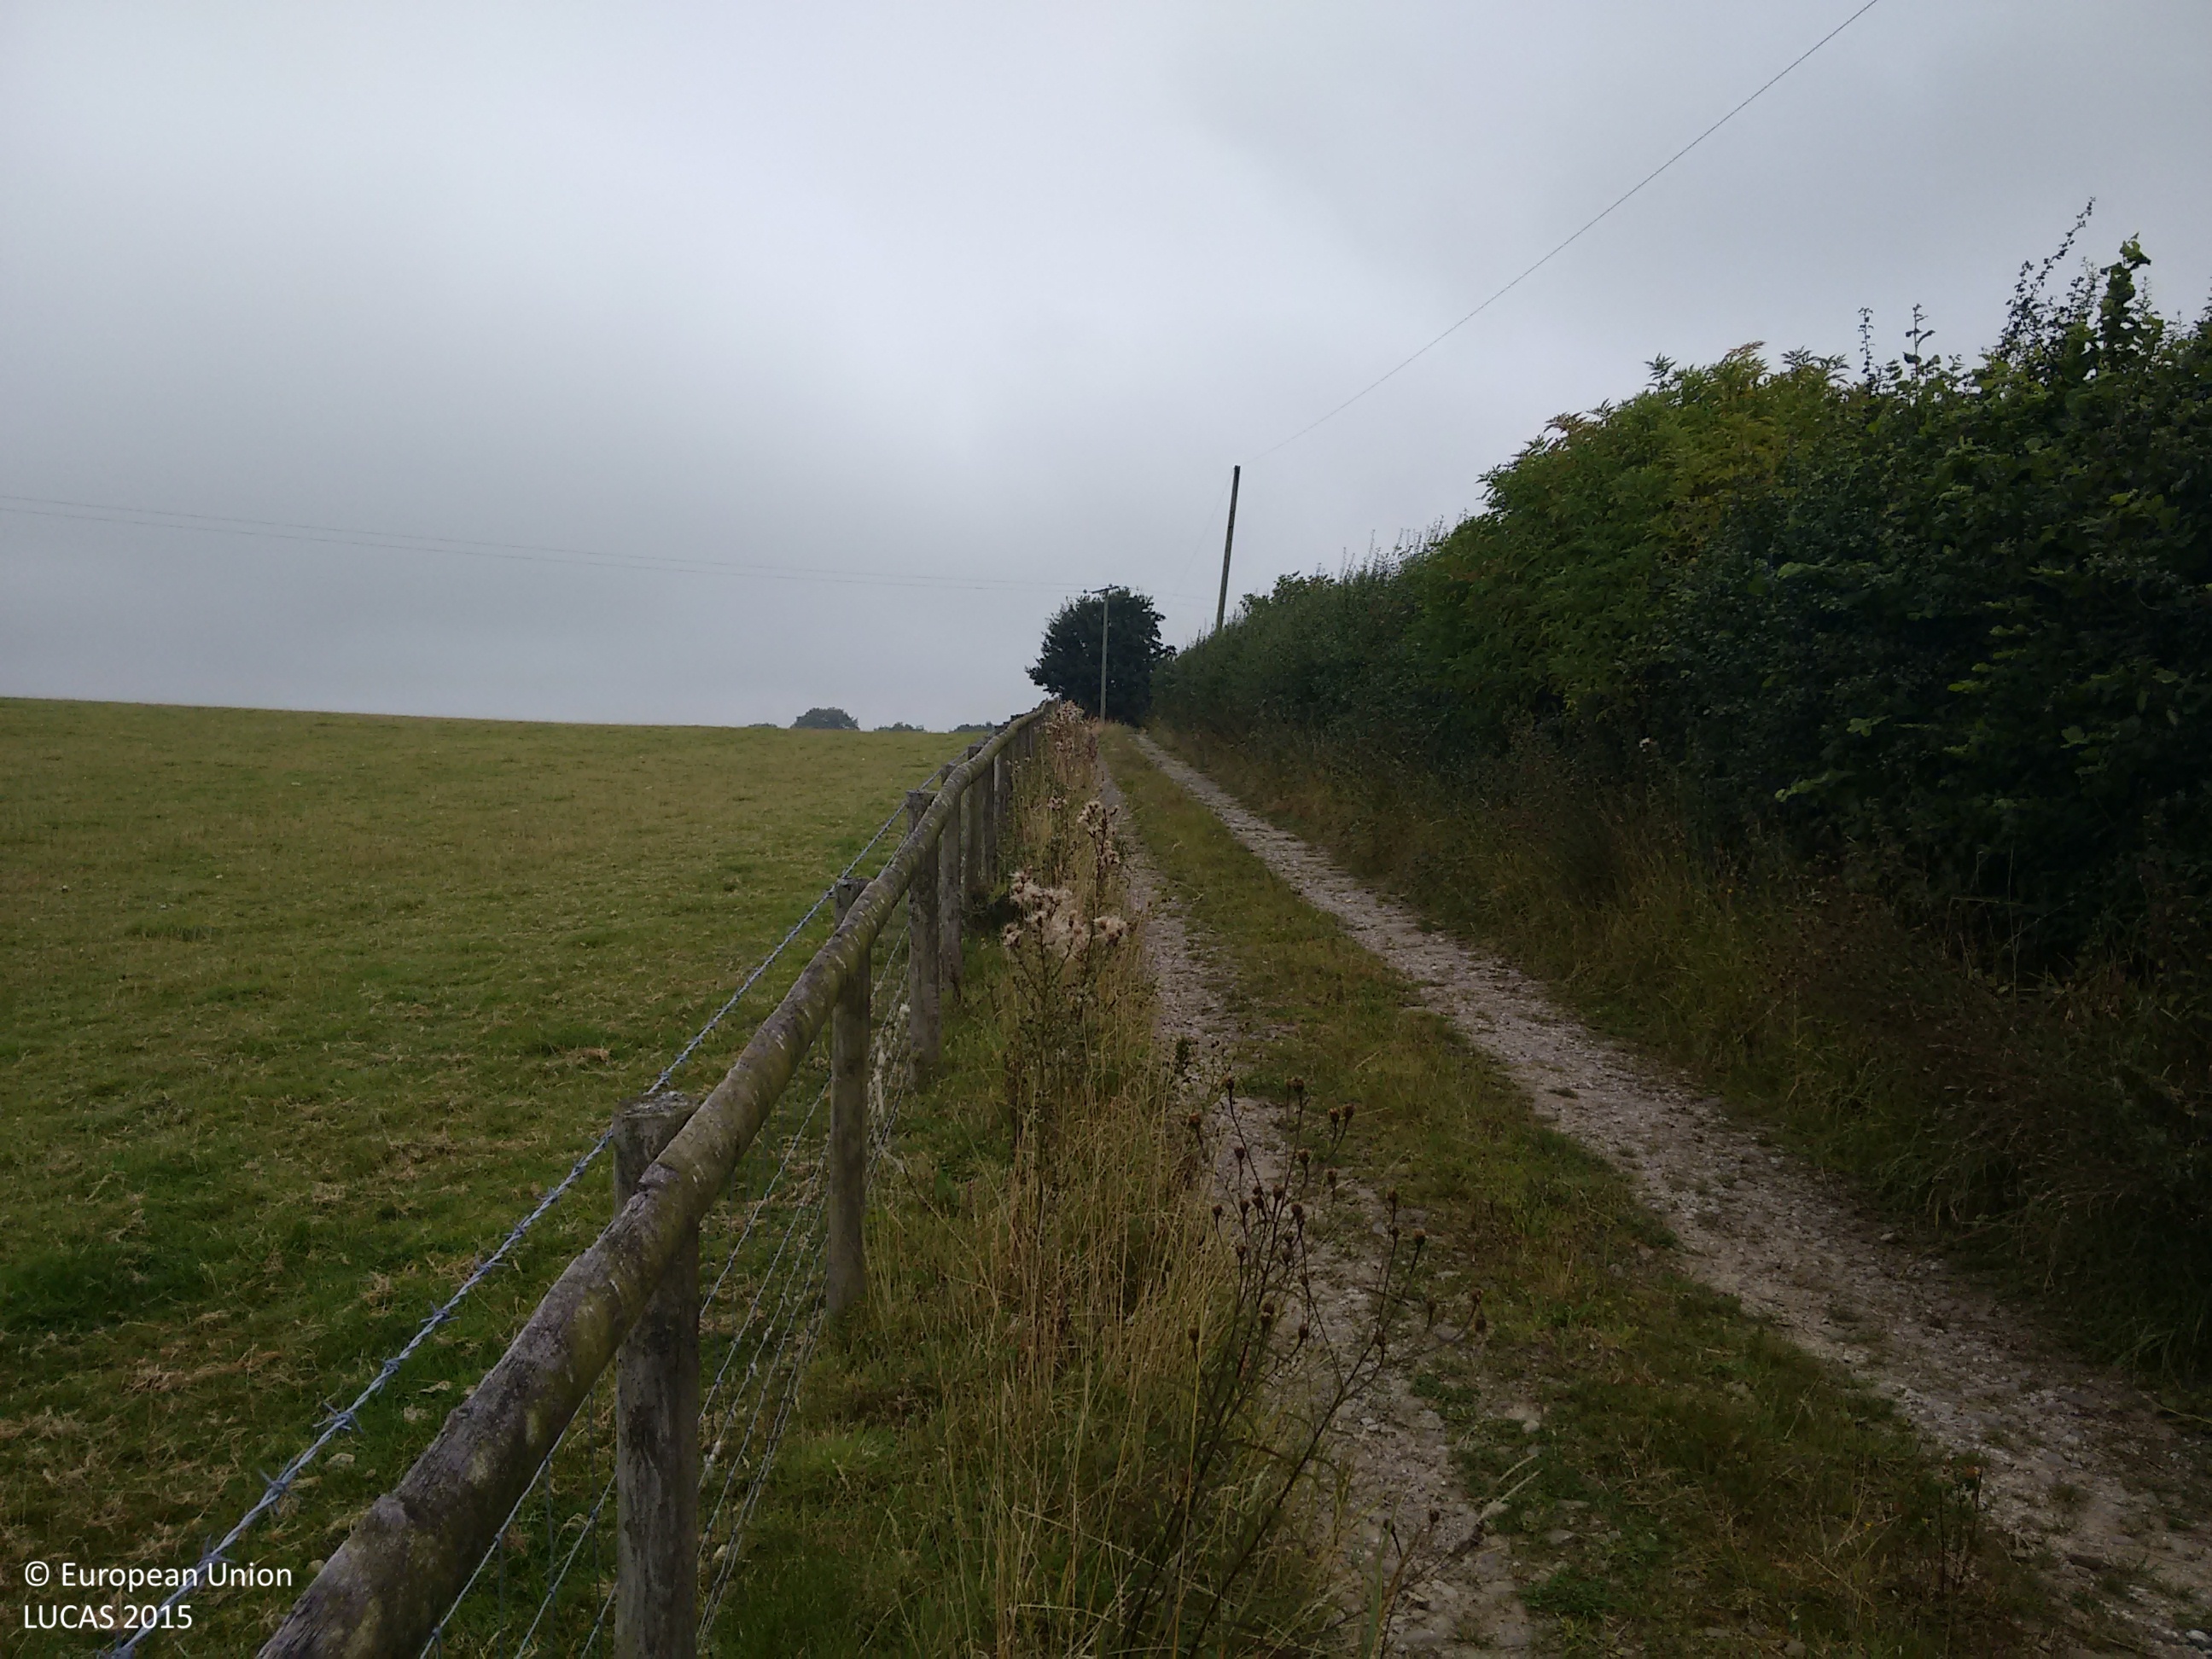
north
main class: Grassland
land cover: Grassland without tree/shrub cover
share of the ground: > 75 %
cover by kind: herbaceous plants 100 %
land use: Agriculture (excluding fallow land and kitchen gardens)
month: September
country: GB
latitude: 52.1191
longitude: -3.1193
